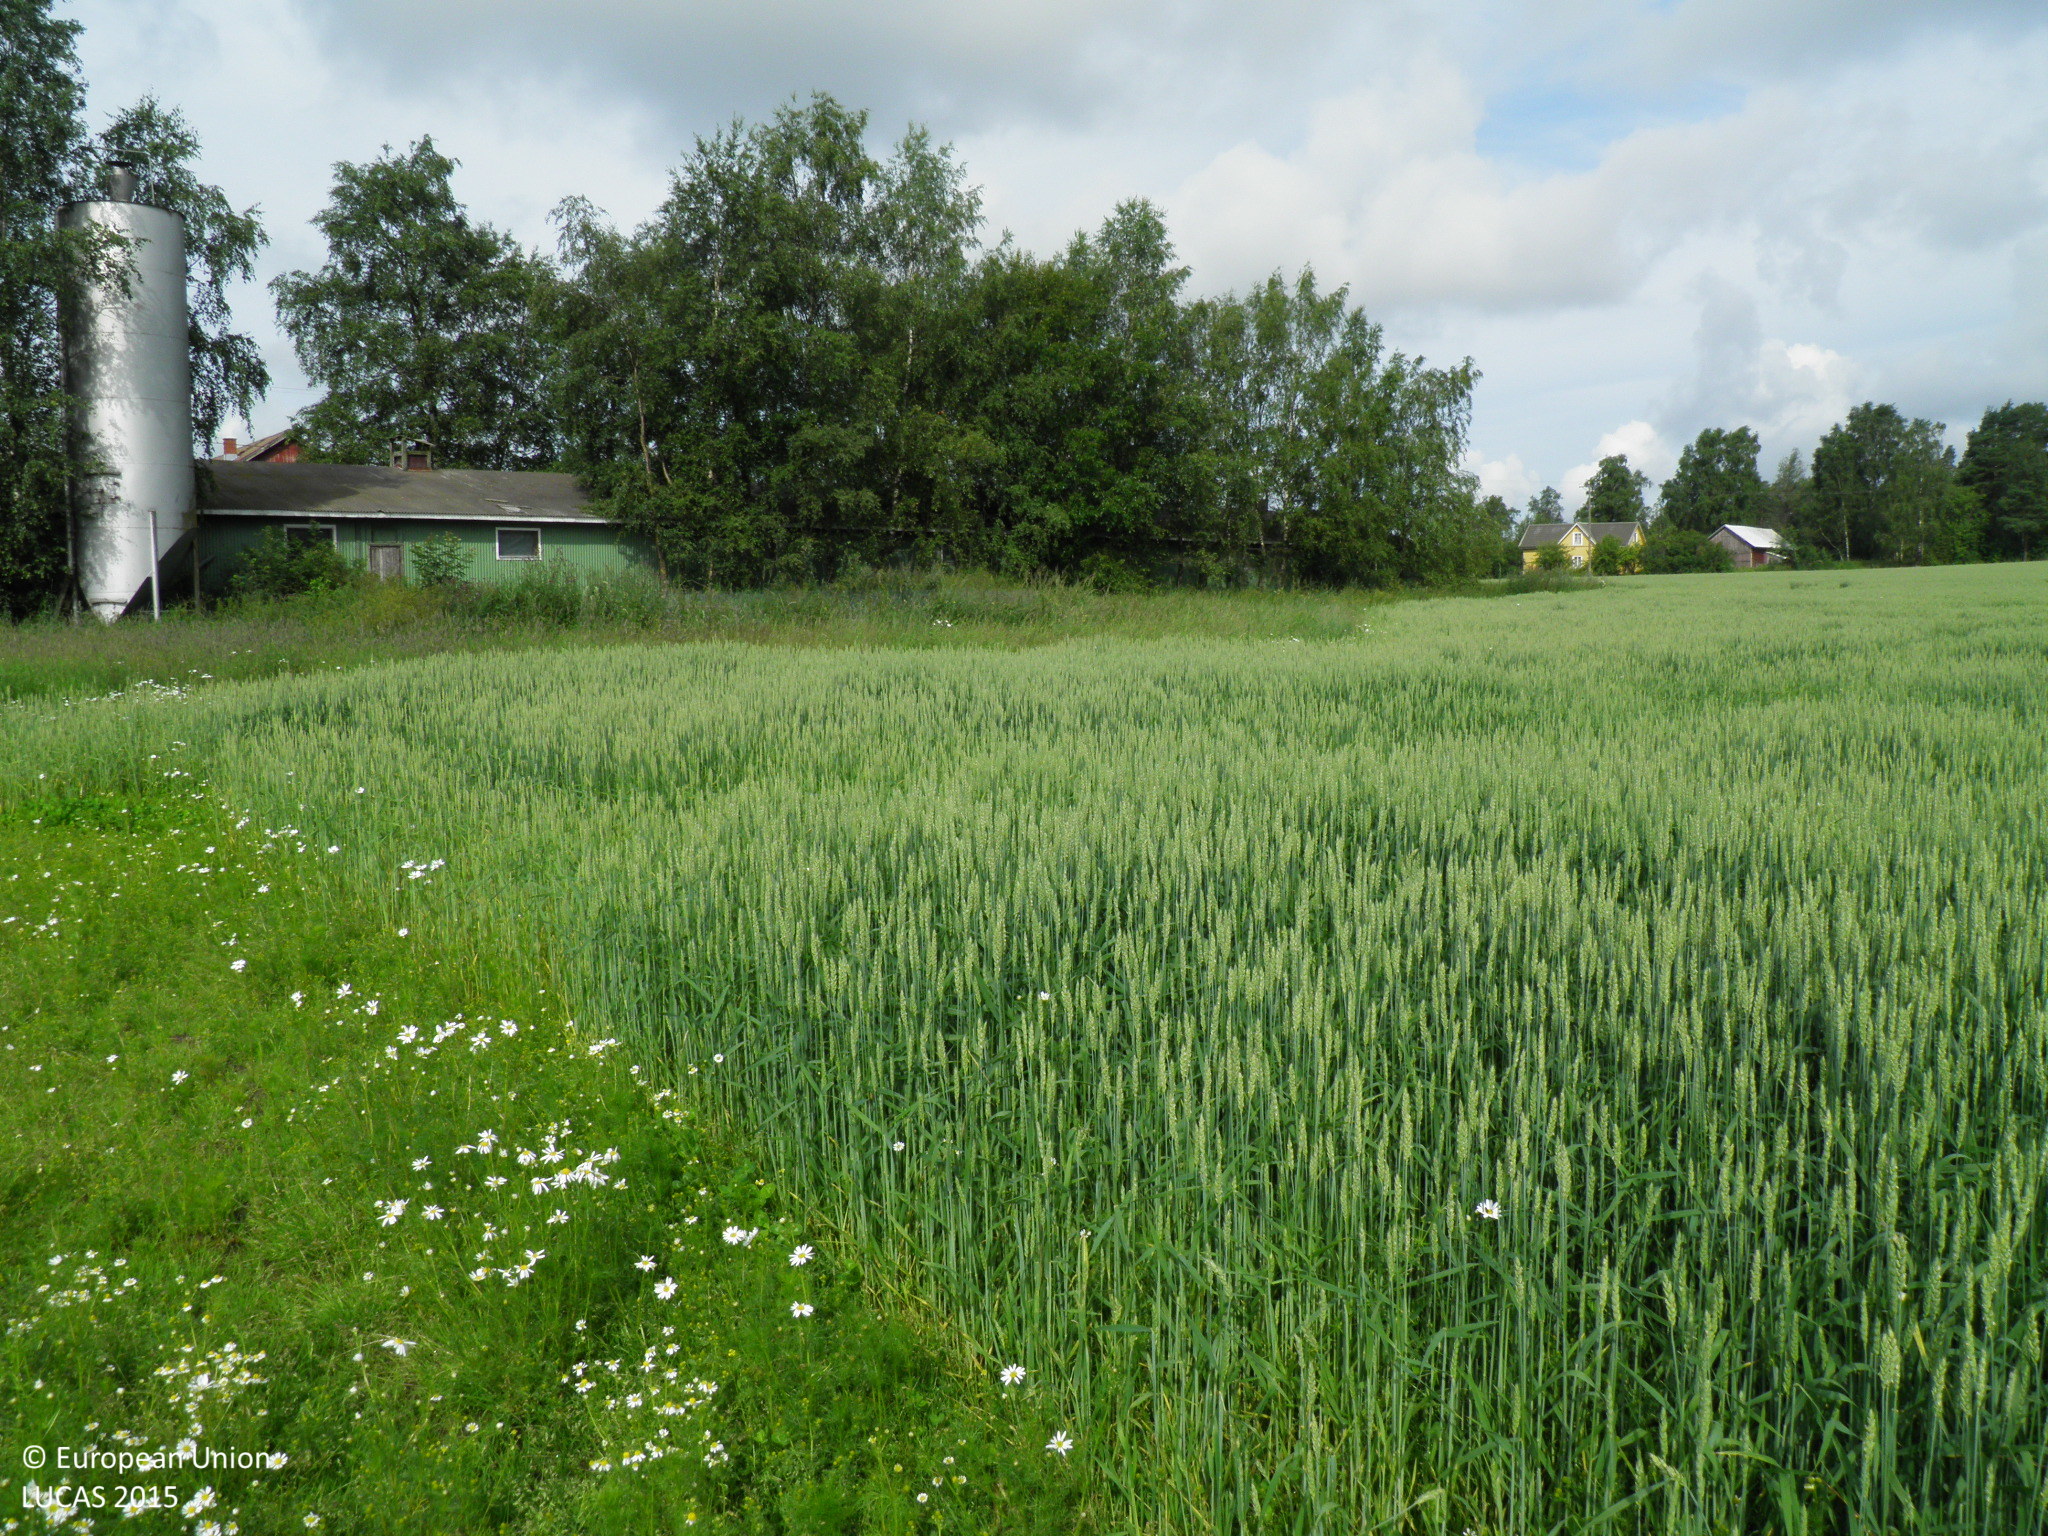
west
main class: Cropland
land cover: Common wheat
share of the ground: > 75 %
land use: Agriculture (excluding fallow land and kitchen gardens)
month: July
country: FI
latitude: 60.6867
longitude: 21.5740
